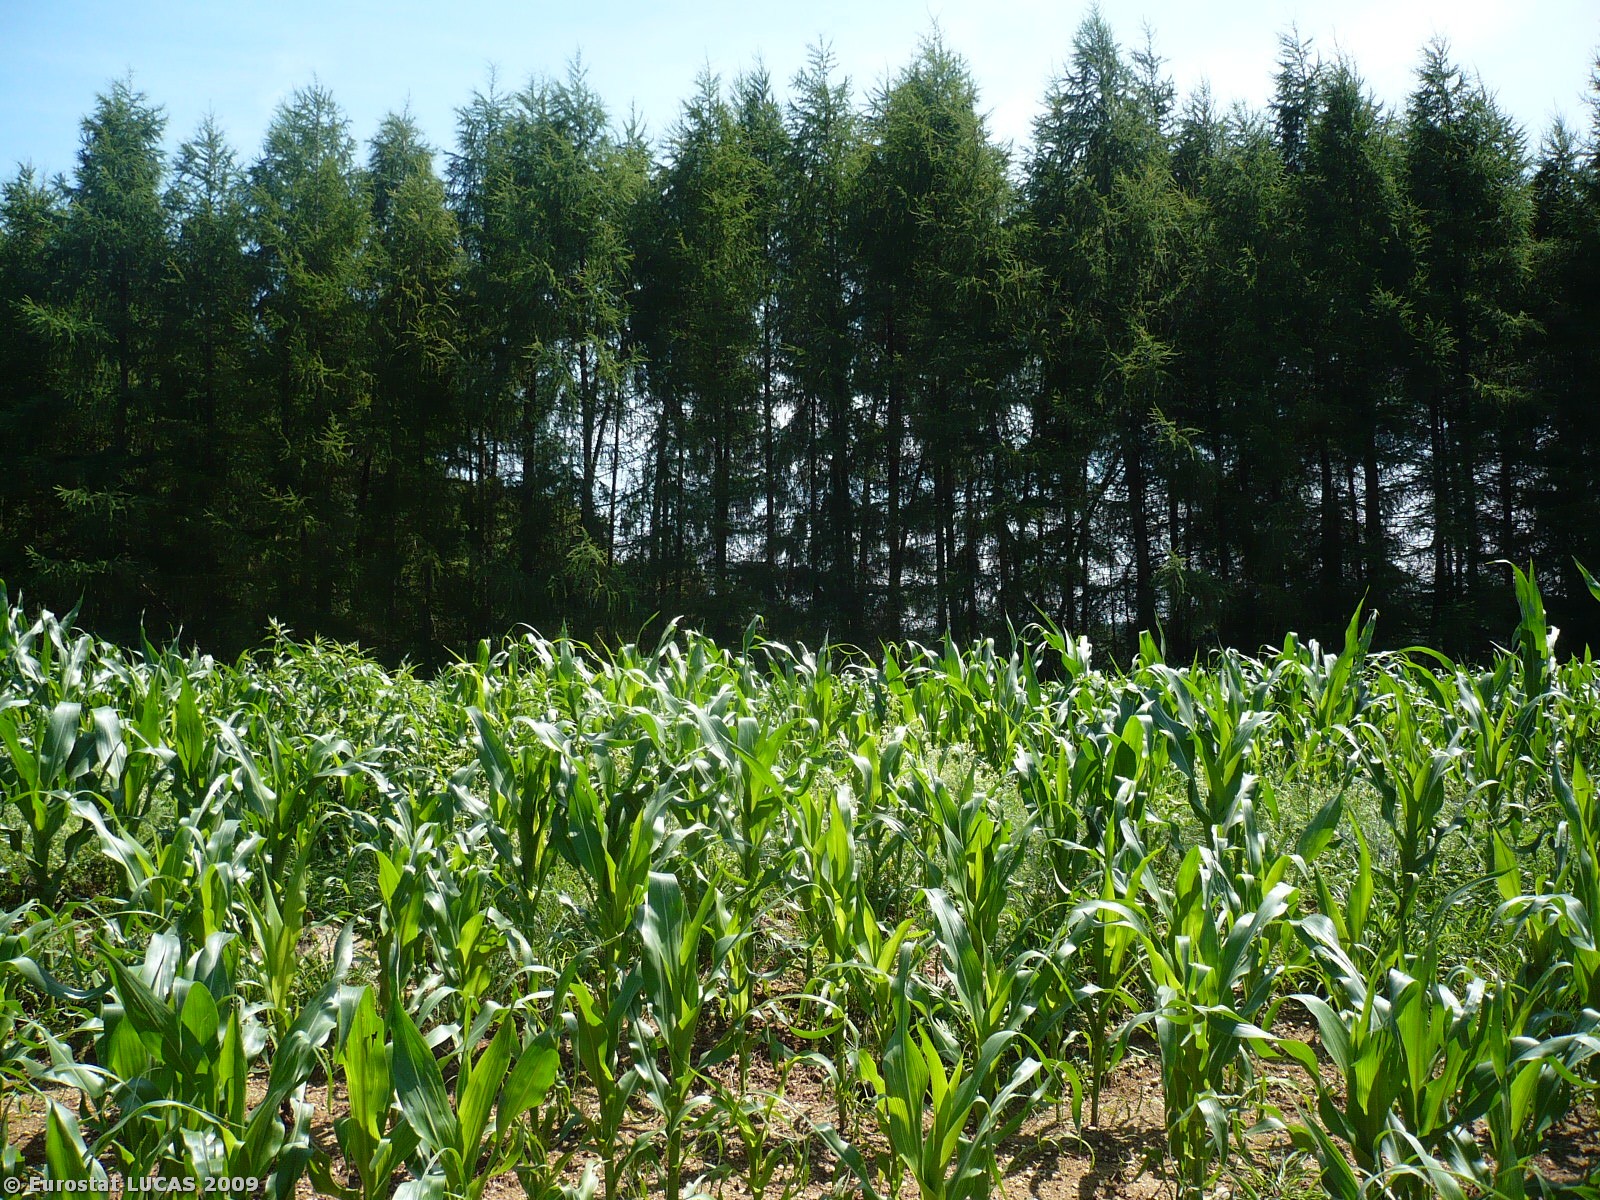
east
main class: Cropland
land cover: Maize
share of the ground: > 75 %
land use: Agriculture (excluding fallow land and kitchen gardens)
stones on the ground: < 10 %
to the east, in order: Maize; Grass margins; Fences; Maize; Coniferous woodland; Grassland without tree/shrub cover; Shrubland with sparse tree cover; Coniferous woodland; Tracks; Broadleaved woodland
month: June
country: SI
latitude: 46.4521
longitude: 16.0274
